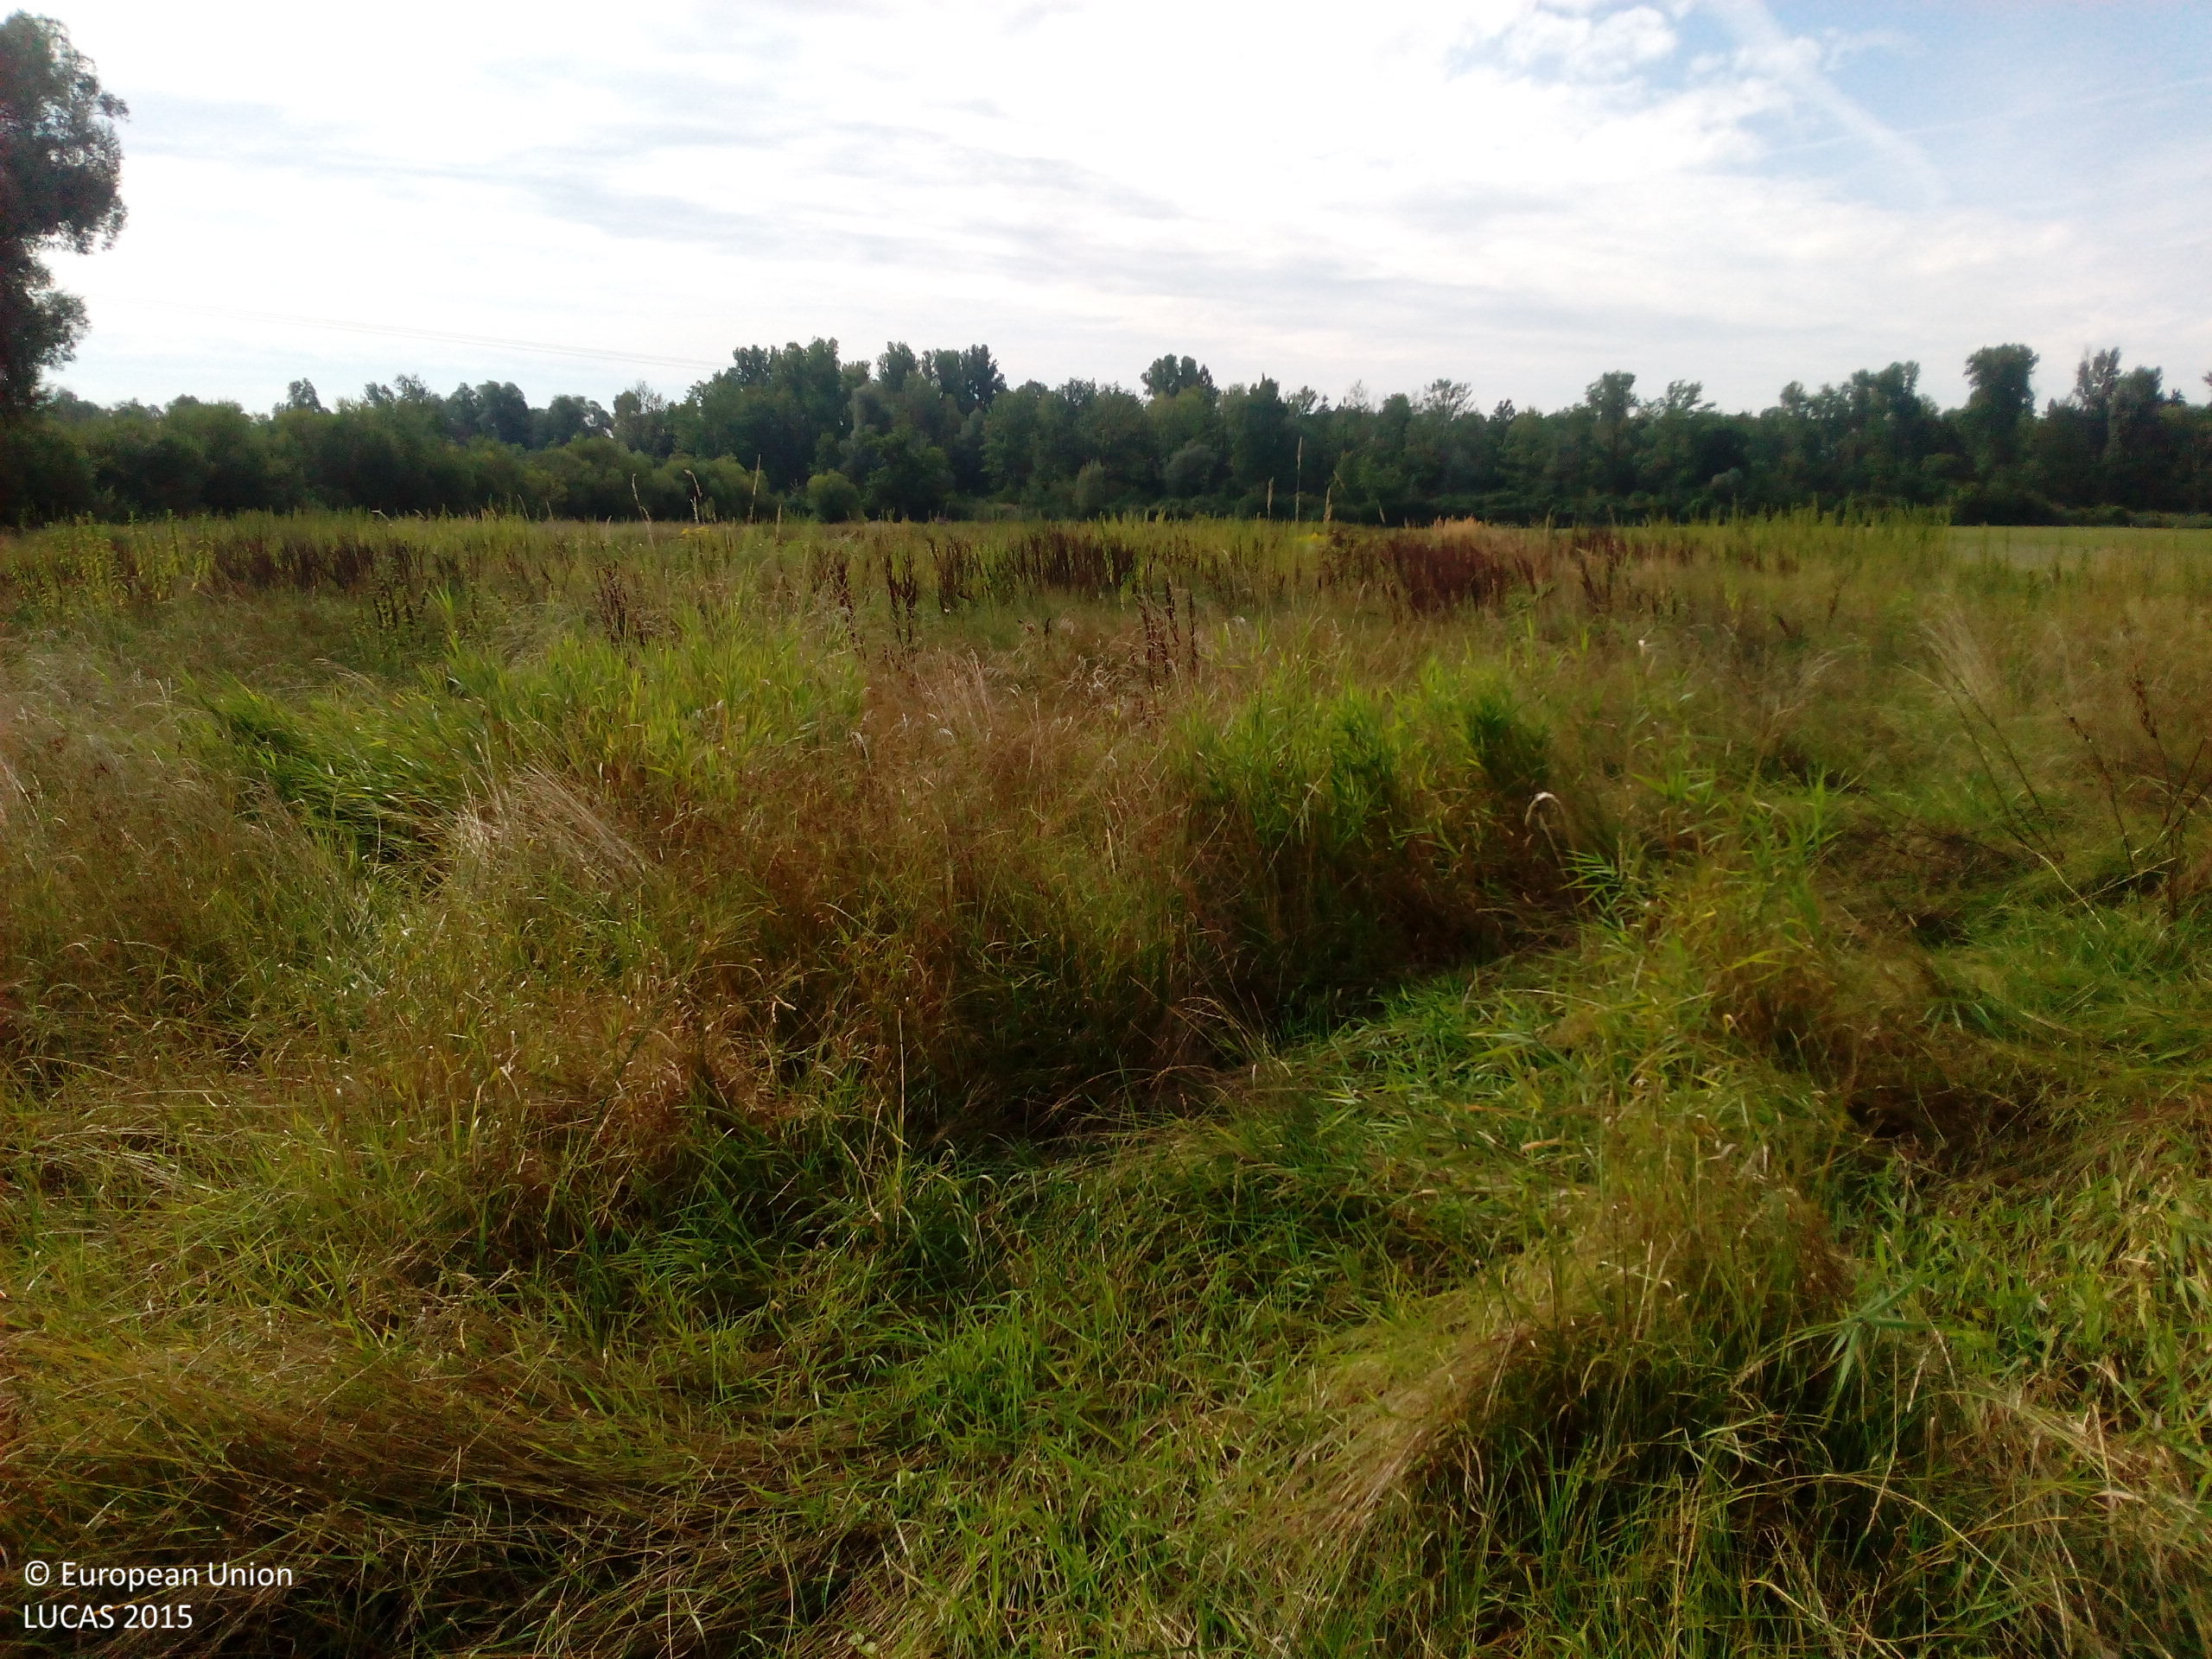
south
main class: Grassland
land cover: Grassland without tree/shrub cover
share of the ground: > 75 %
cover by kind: herbaceous plants 100 %
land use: Agriculture (excluding fallow land and kitchen gardens)
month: August
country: DE
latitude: 48.7782
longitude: 12.9525
